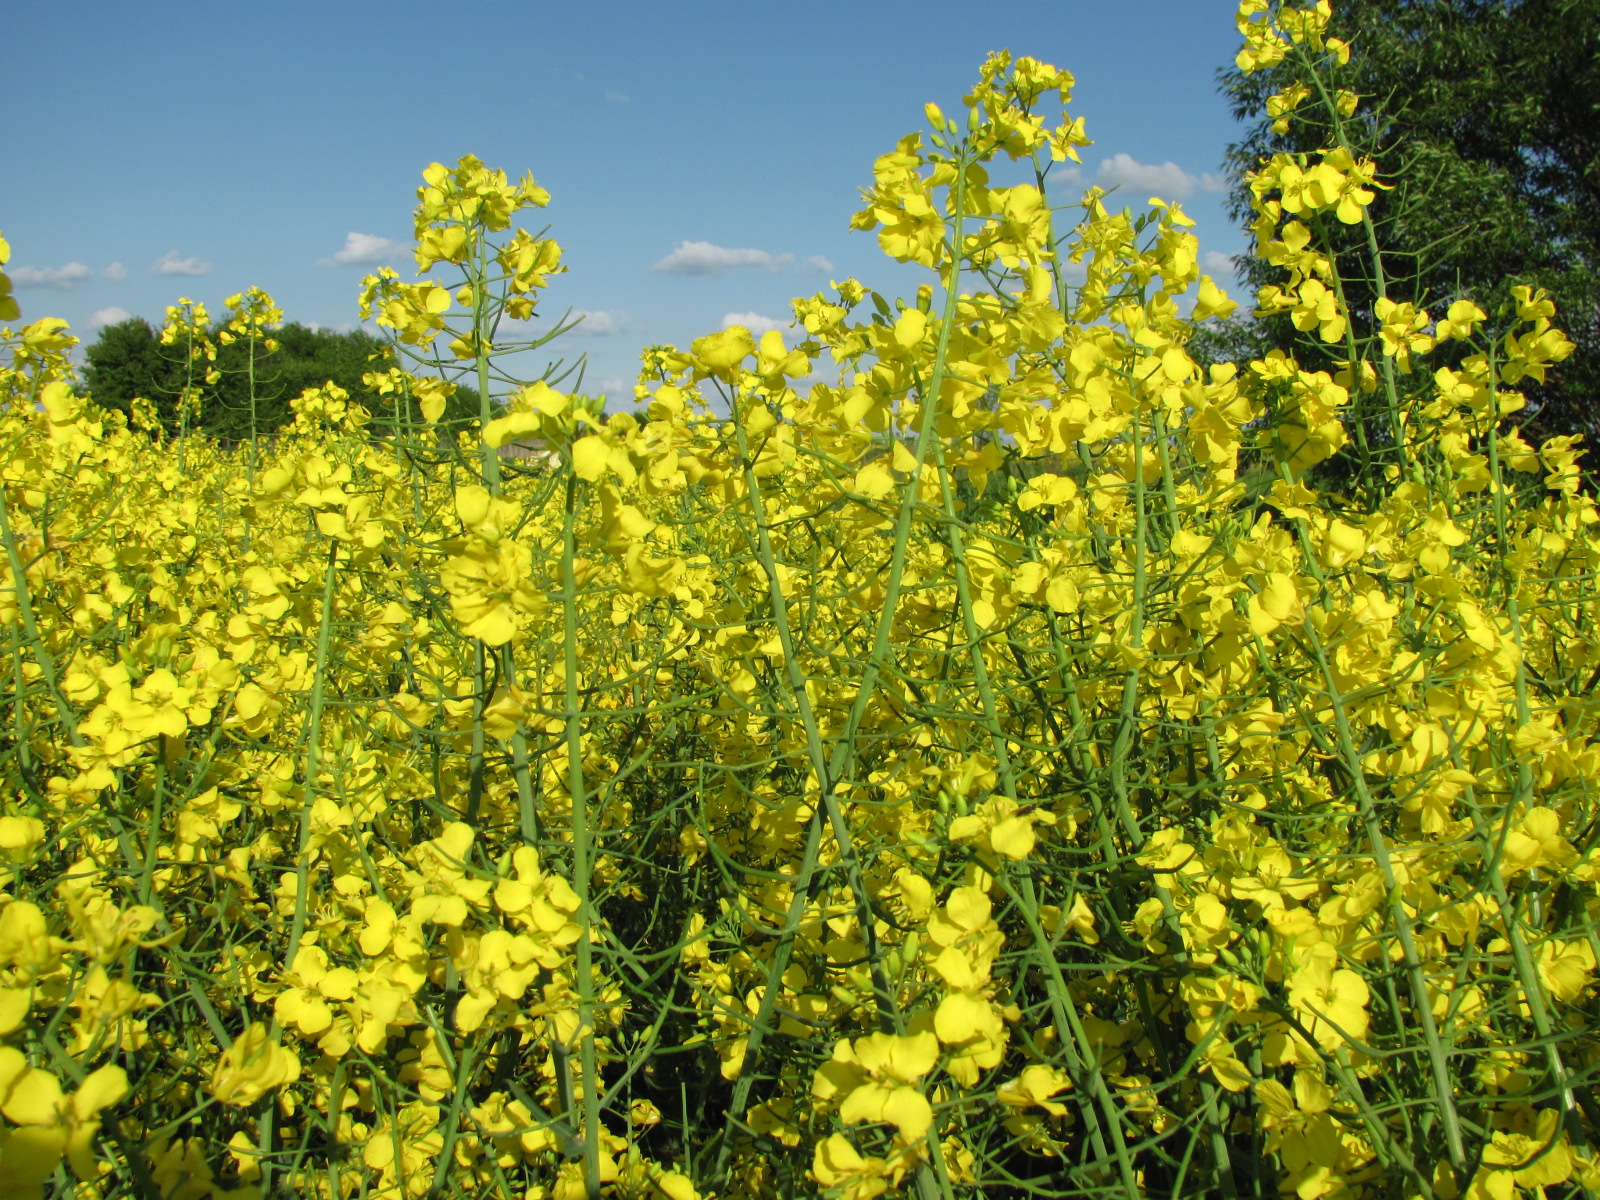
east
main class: Cropland
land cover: Rape and turnip rape
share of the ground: > 75 %
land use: Agriculture (excluding fallow land and kitchen gardens)
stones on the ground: < 10 %
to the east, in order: Rape and turnip rape; Spontaneously vegetated surfaces; Broadleaved woodland; Rape and turnip rape; Electric lines; Grass margins; Ditches and canals; Grassland without tree/shrub cover
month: May
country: LV
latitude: 56.5177
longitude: 23.9477
